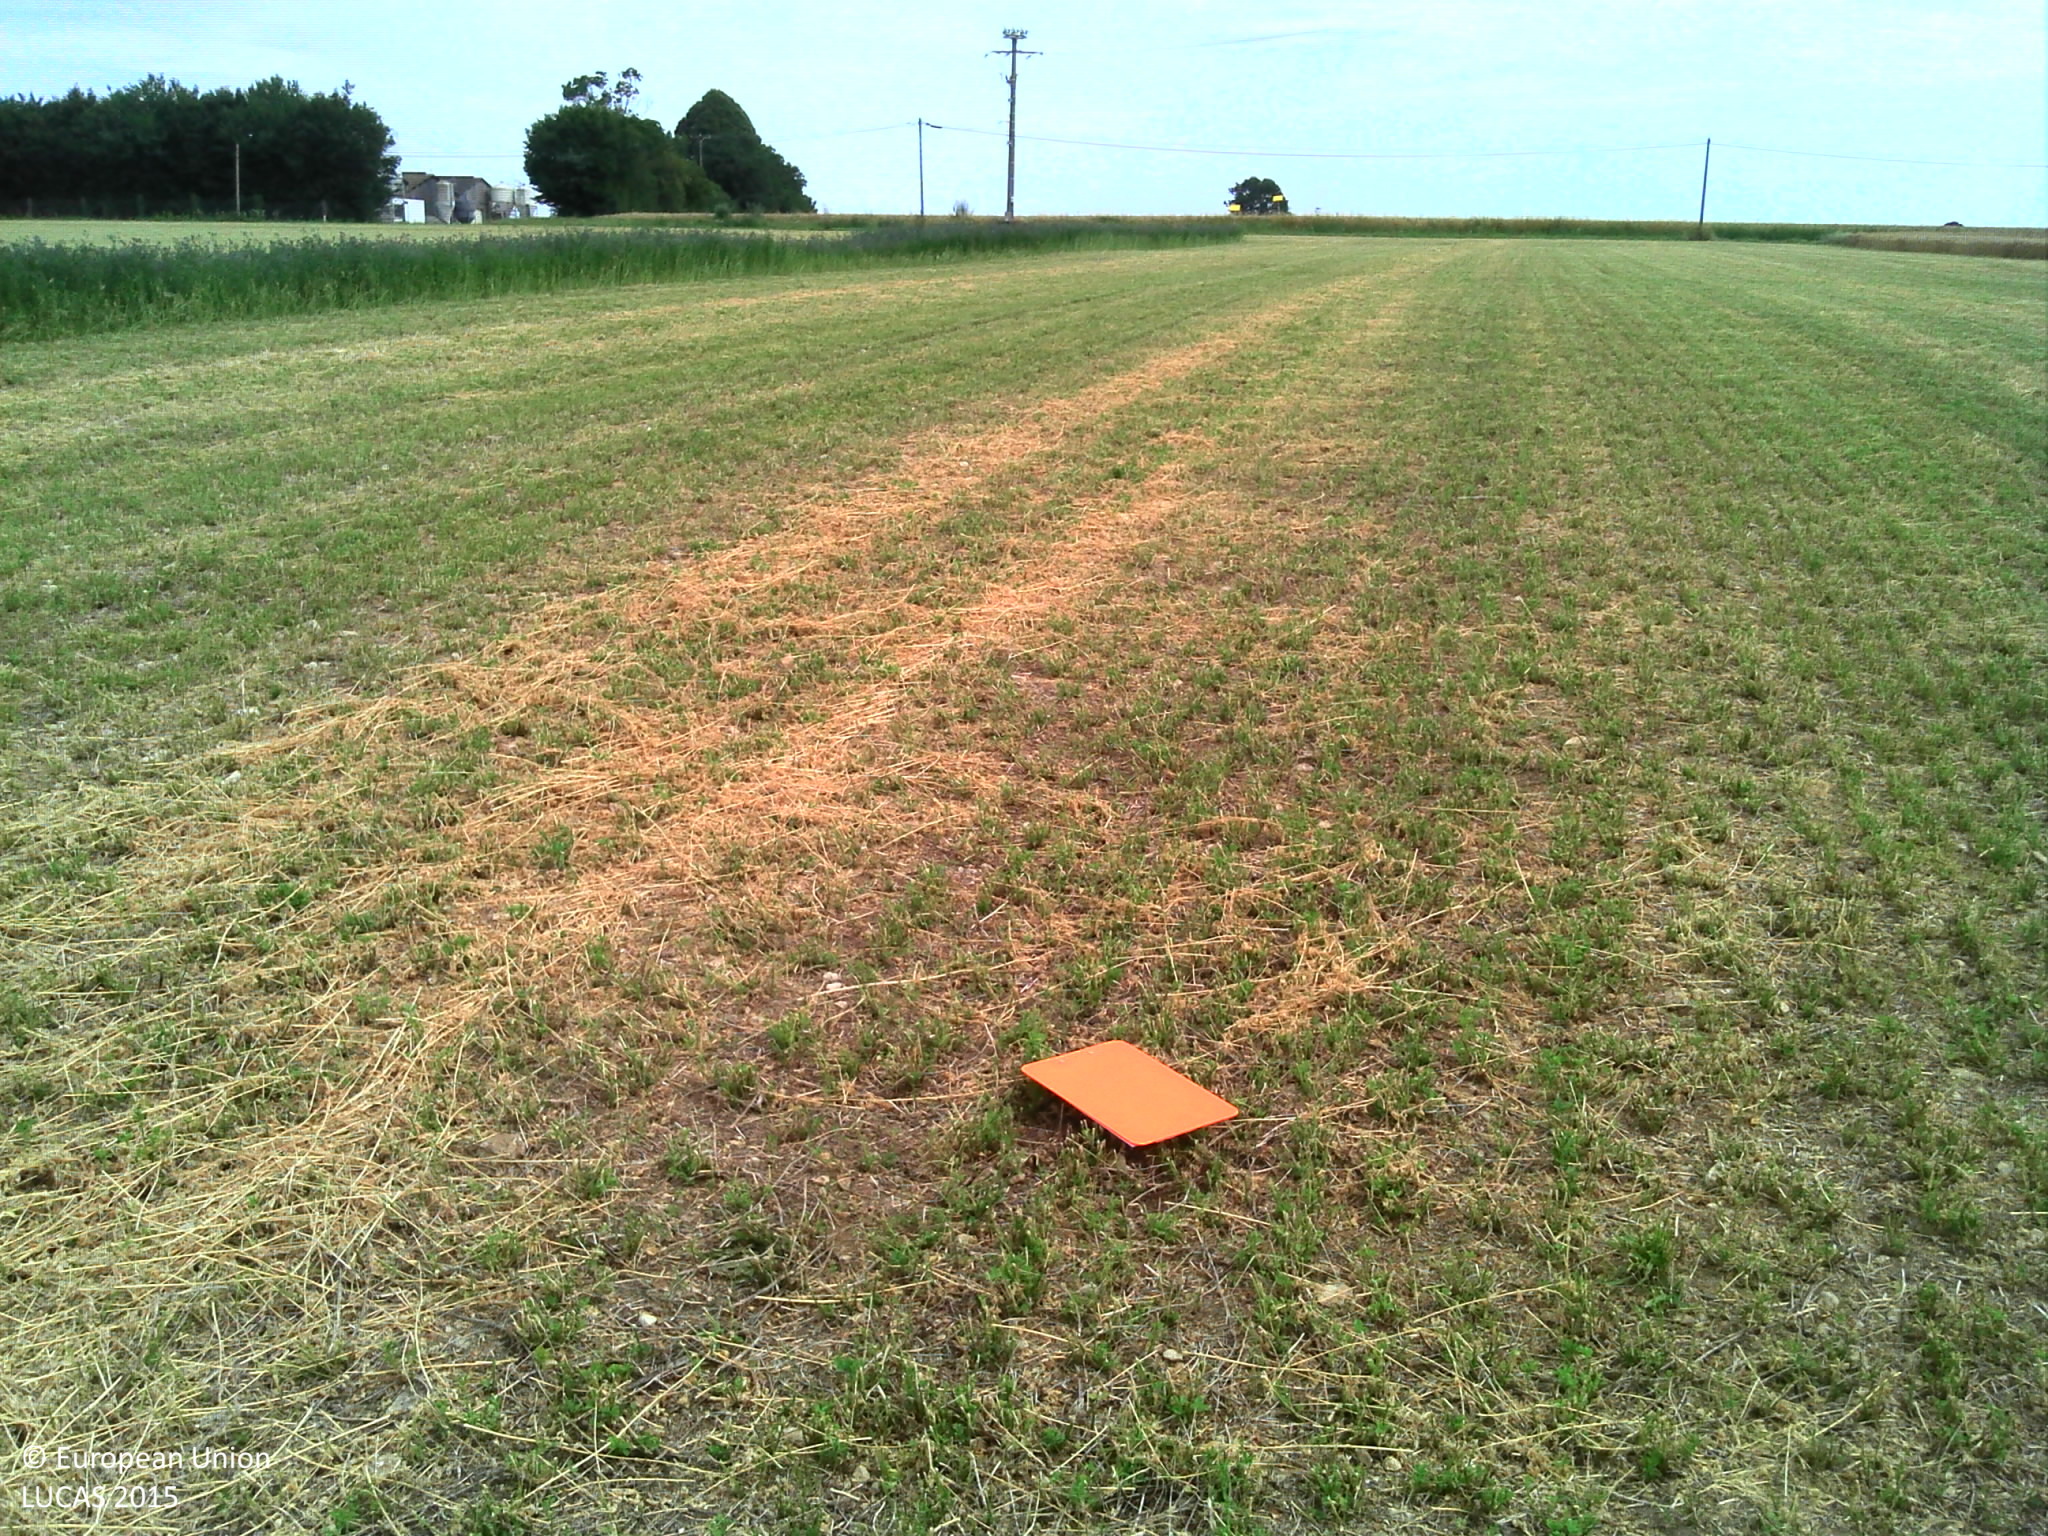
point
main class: Cropland
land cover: Lucerne
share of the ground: < 10 %
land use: Agriculture (excluding fallow land and kitchen gardens)
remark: Harvested field
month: July
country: FR
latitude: 49.0523
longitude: -0.2272
